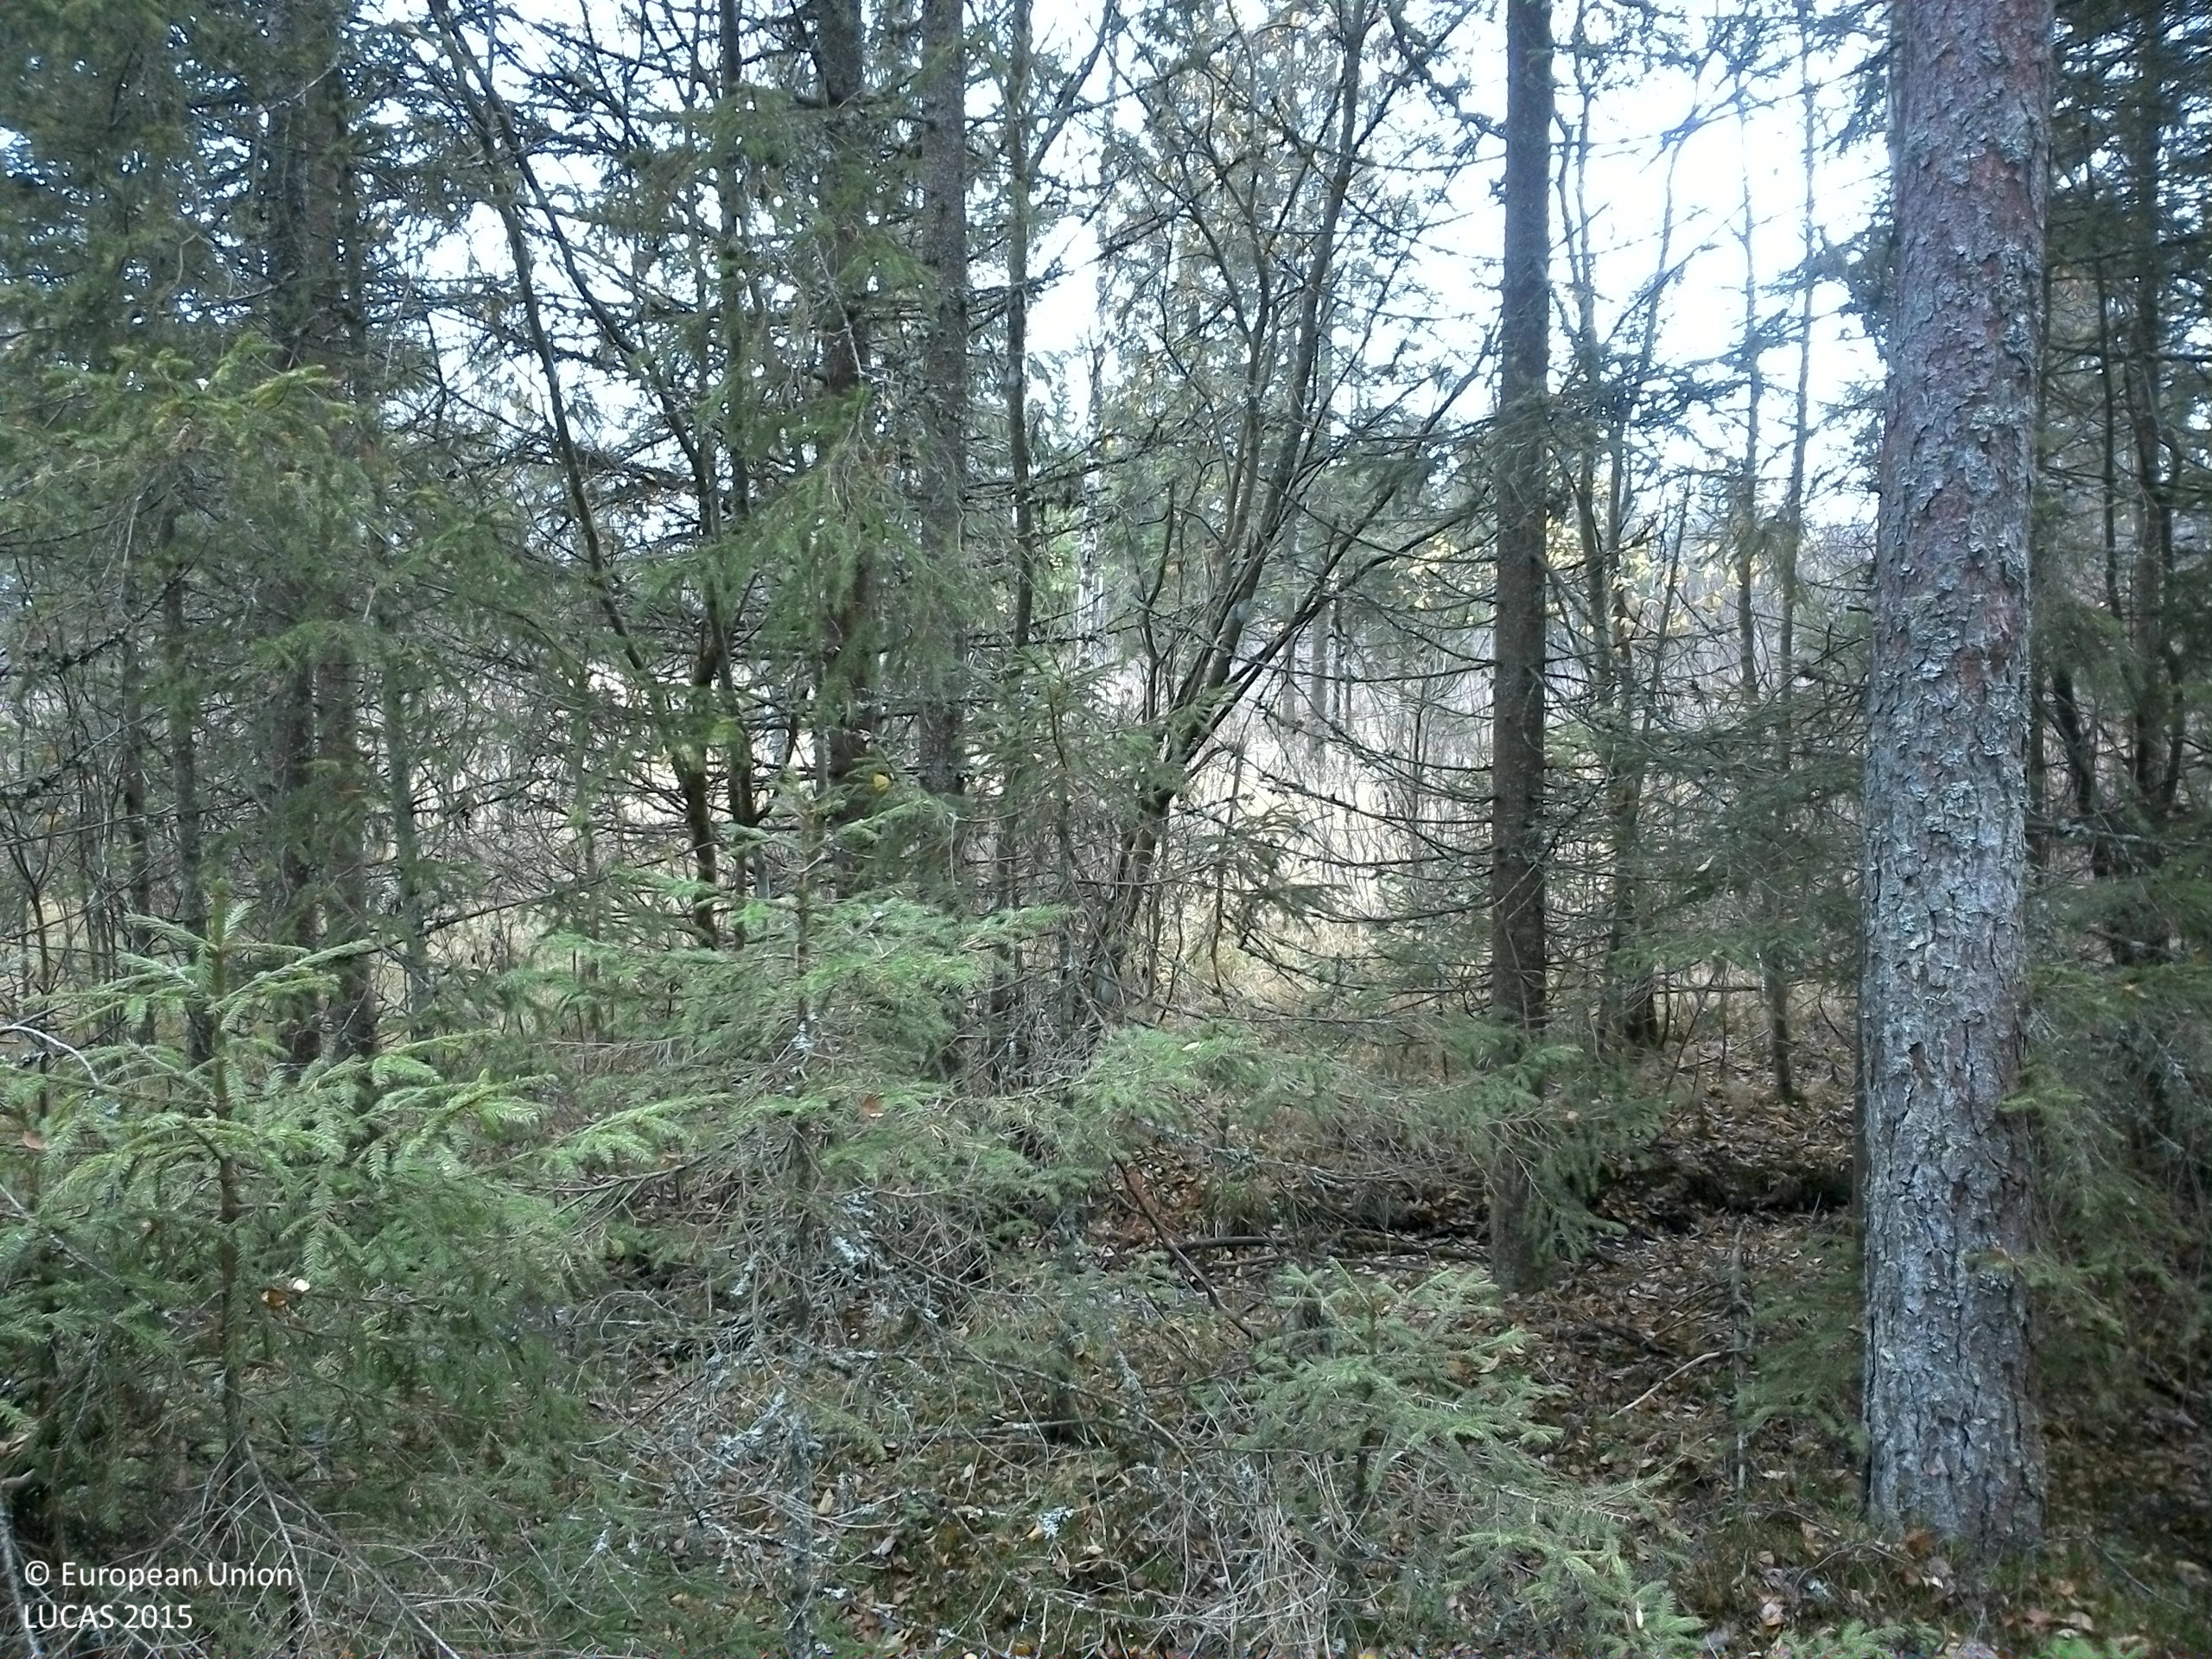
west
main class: Woodland
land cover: Spruce dominated mixed woodland
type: boreal forest
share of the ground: 50 - 75 %
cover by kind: coniferous forest trees 45 %, broadleaved forest trees 25 %, shrubs 10 %, herbaceous plants 10 %, lichens and mosses 10 %
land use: Forestry
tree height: > 5 m
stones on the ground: < 10 %
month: November
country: SE
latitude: 57.5946
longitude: 14.7638
